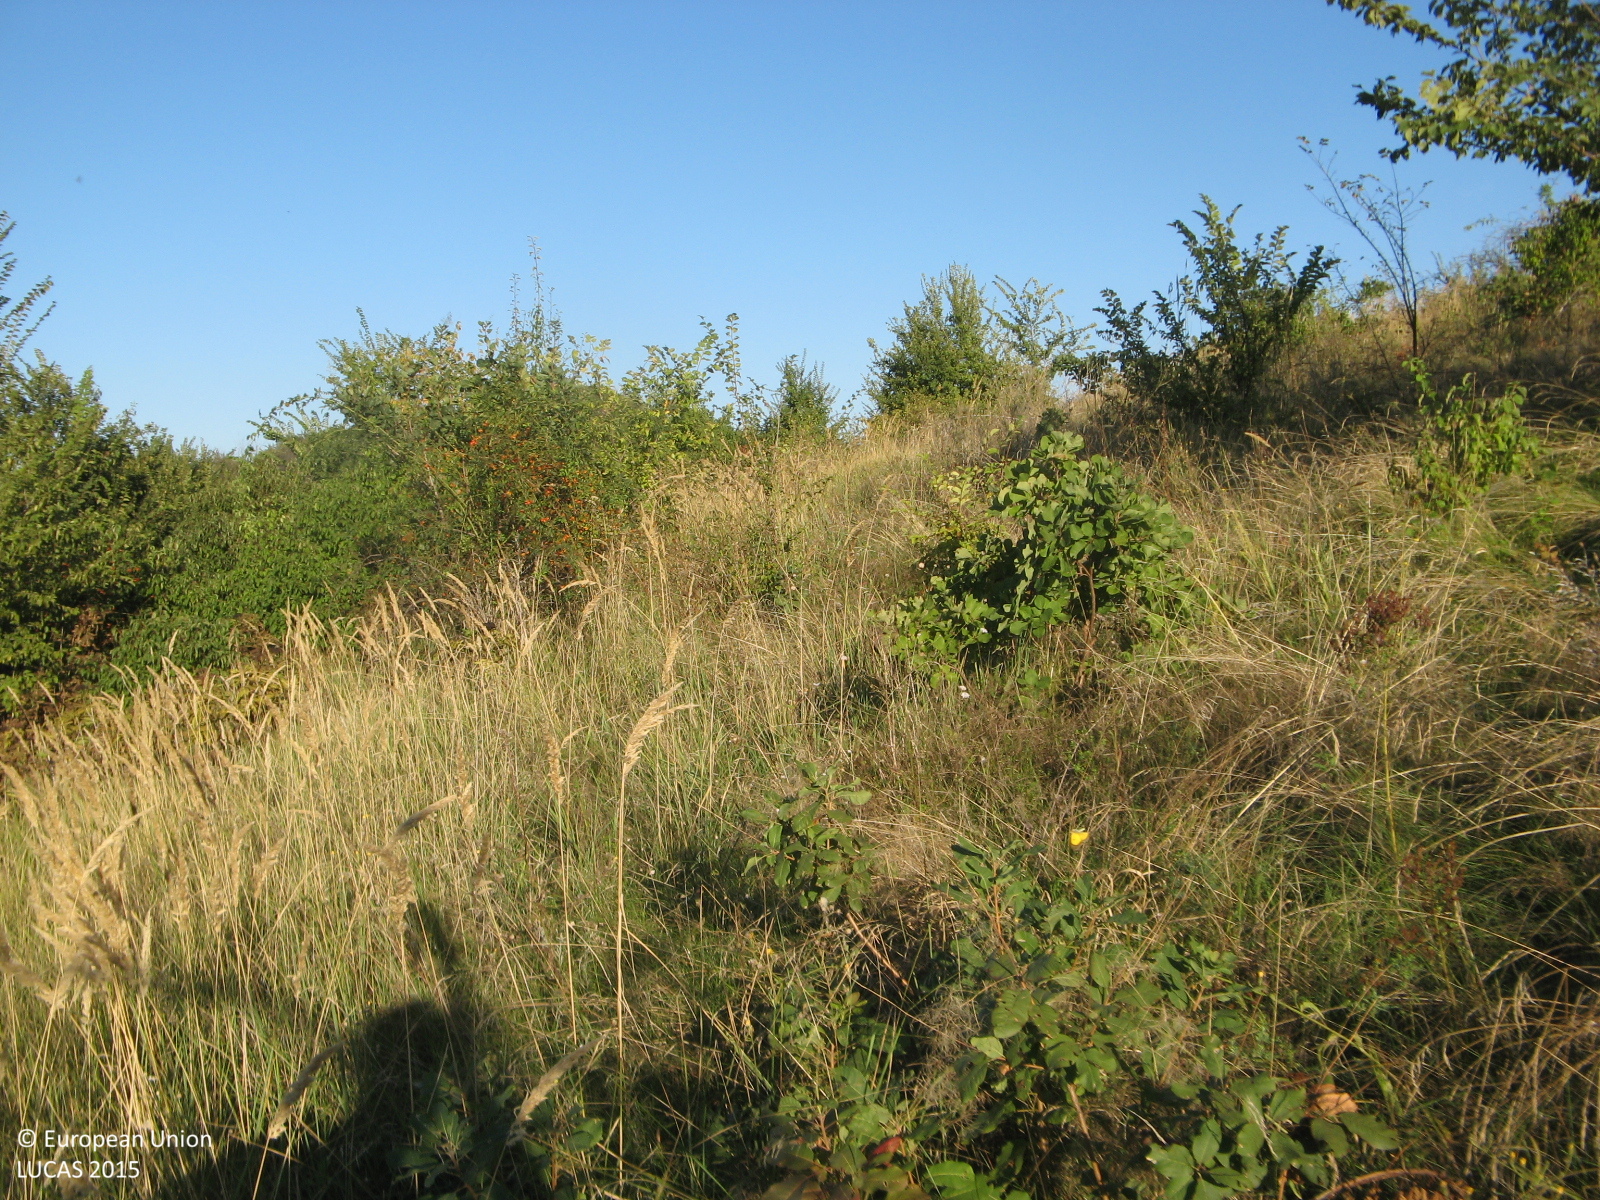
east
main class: Grassland
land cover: Grassland with sparse tree/shrub cover
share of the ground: > 75 %
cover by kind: herbaceous plants 90 %, broadleaved forest trees 5 %, shrubs 5 %
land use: Semi-natural and natural areas not in use
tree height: < 5 m
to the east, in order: Grassland with sparse tree/shrub cover; Shrubland with sparse tree cover; Grassland with sparse tree/shrub cover; Shrubland with sparse tree cover; Common wheat; Spontaneously vegetated surfaces
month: September
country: BG
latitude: 43.6096
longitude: 25.4324
